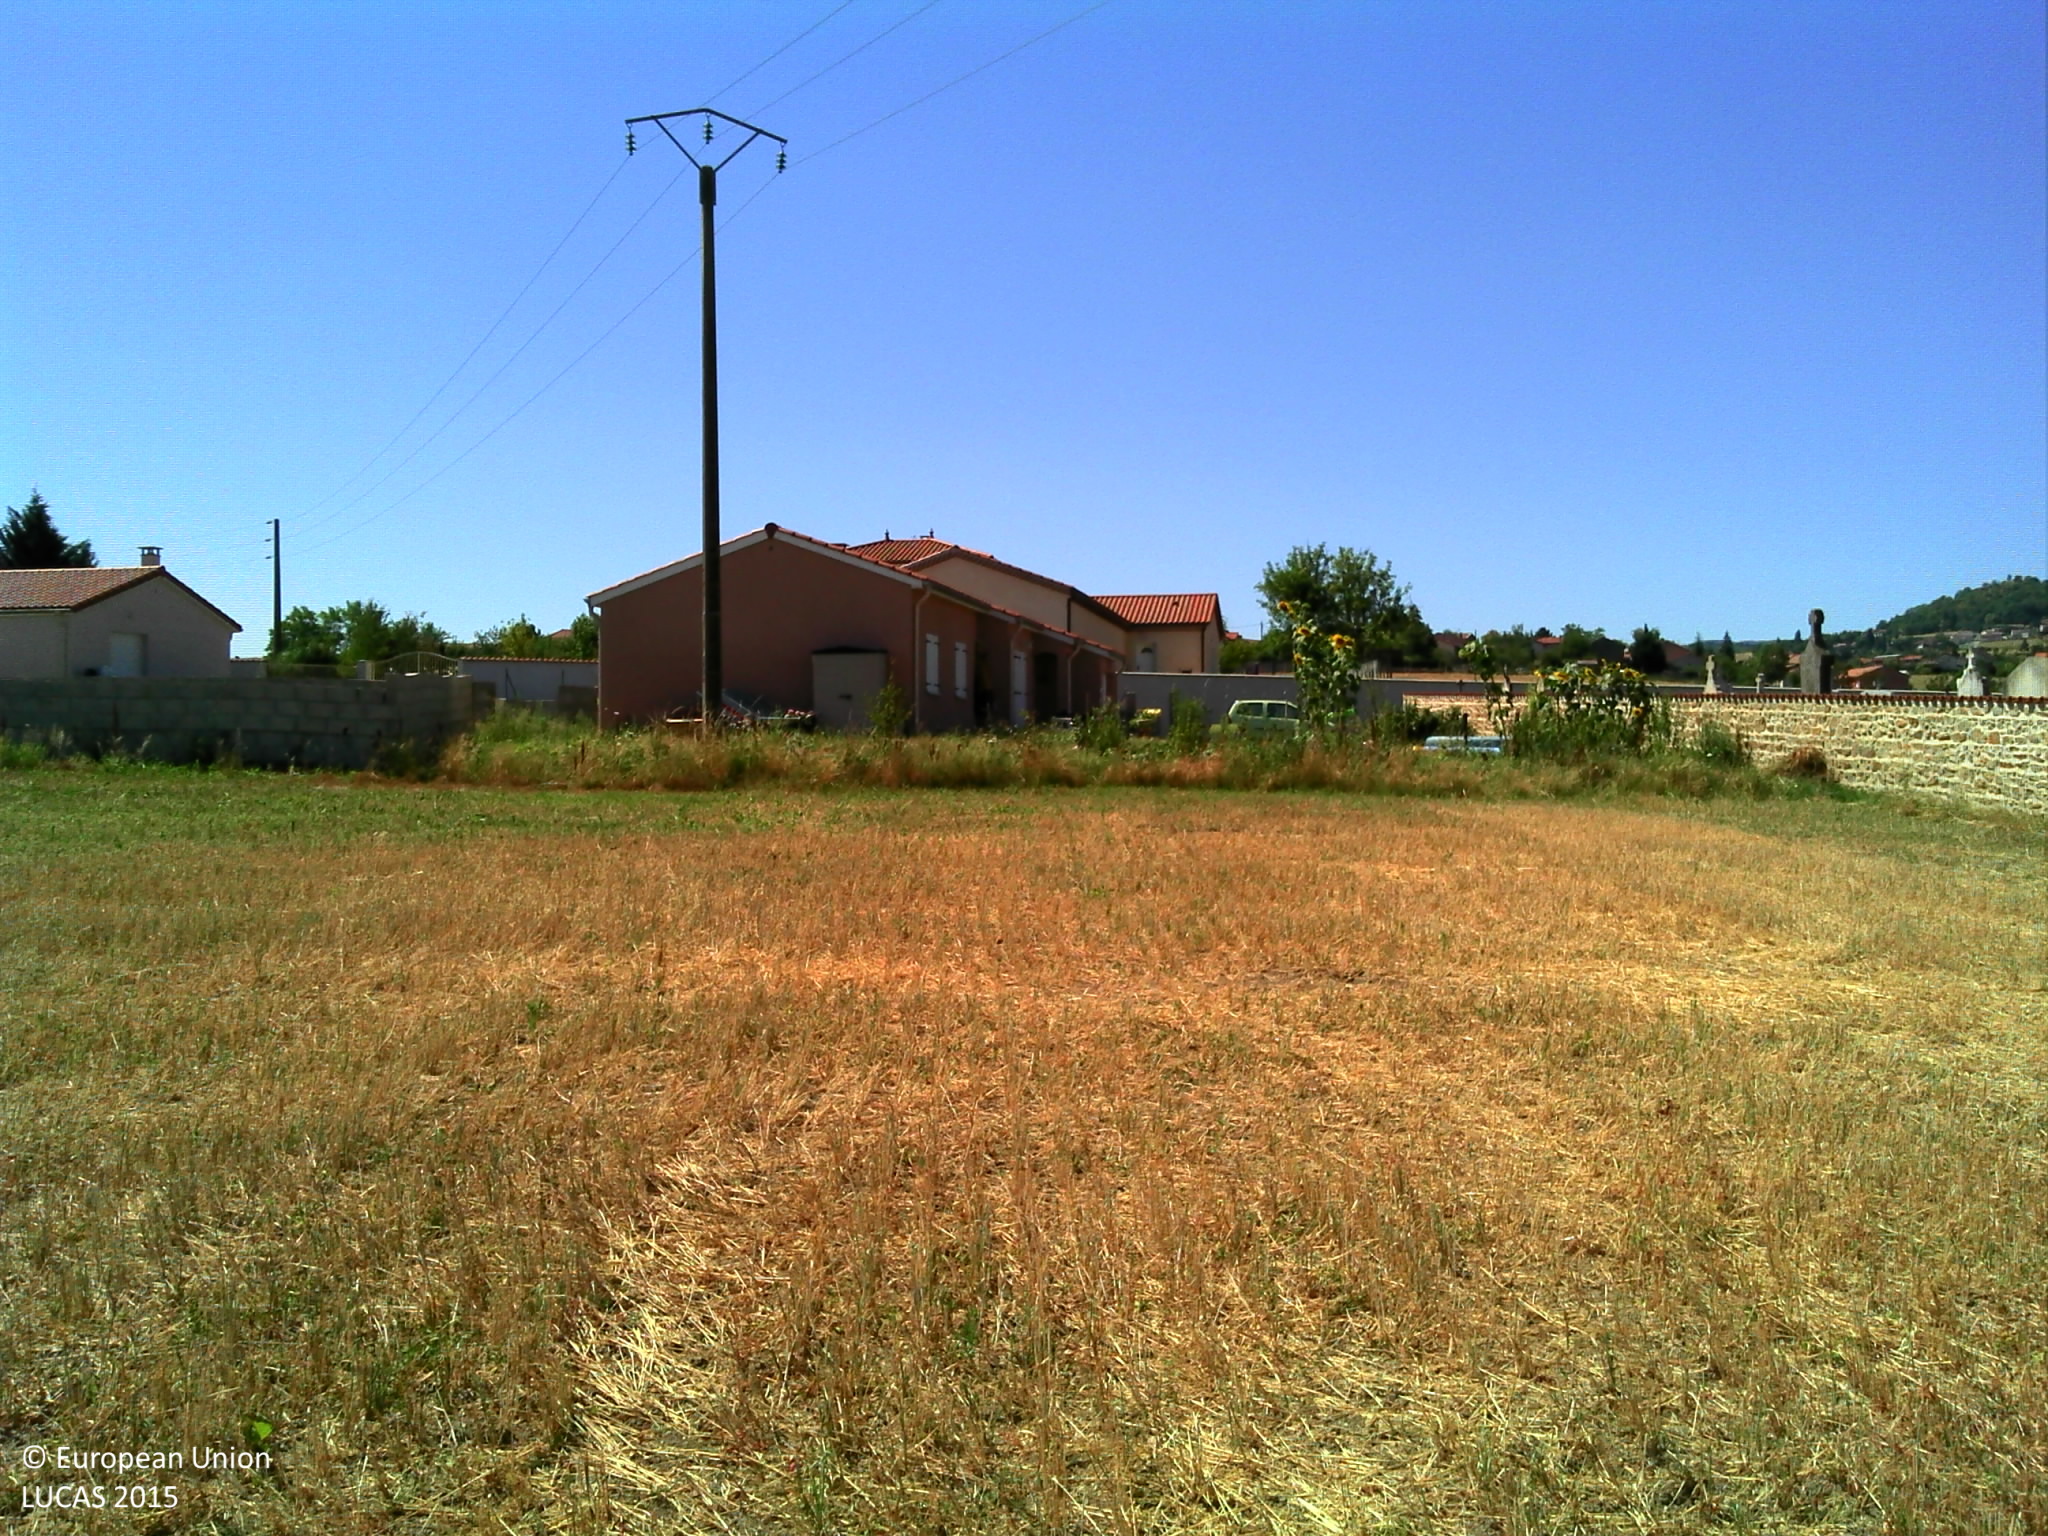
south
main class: Cropland
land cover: Barley
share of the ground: > 75 %
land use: Agriculture (excluding fallow land and kitchen gardens)
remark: Harvested field
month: July
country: FR
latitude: 45.5560
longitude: 4.0974
